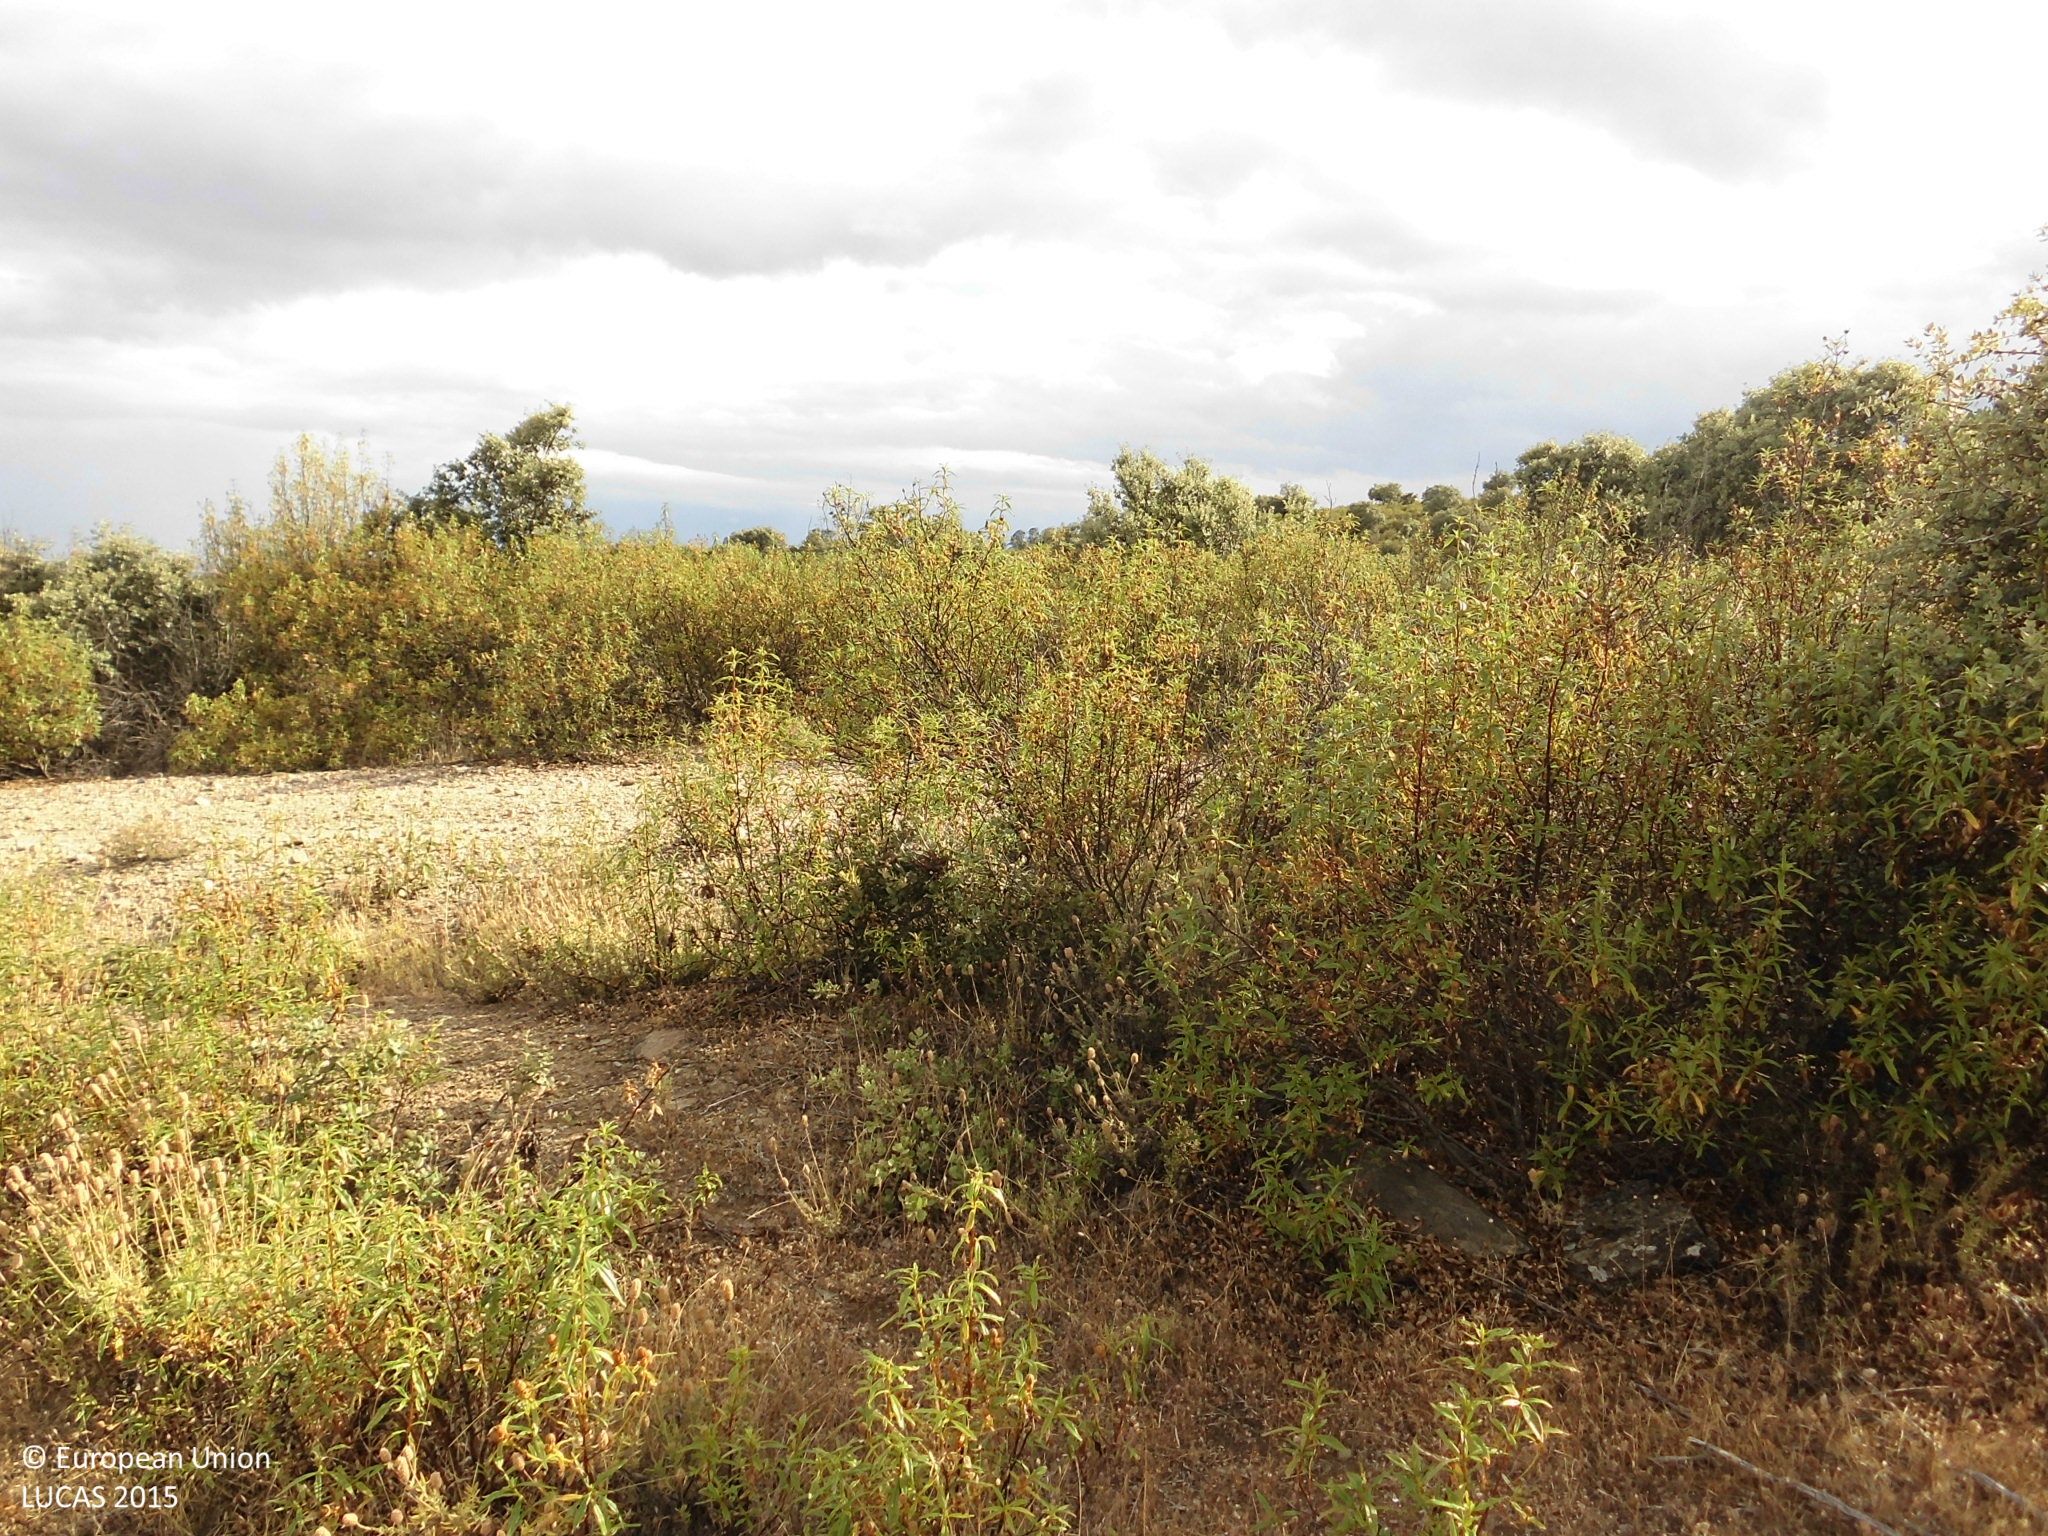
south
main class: Shrubland
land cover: Shrubland with sparse tree cover
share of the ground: 50 - 75 %
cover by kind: shrubs 60 %, herbaceous plants 30 %, broadleaved forest trees 5 %, consolidated bare surface 5 %
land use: Semi-natural and natural areas not in use
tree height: < 5 m
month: June
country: ES
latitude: 39.3346
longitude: -5.8687
